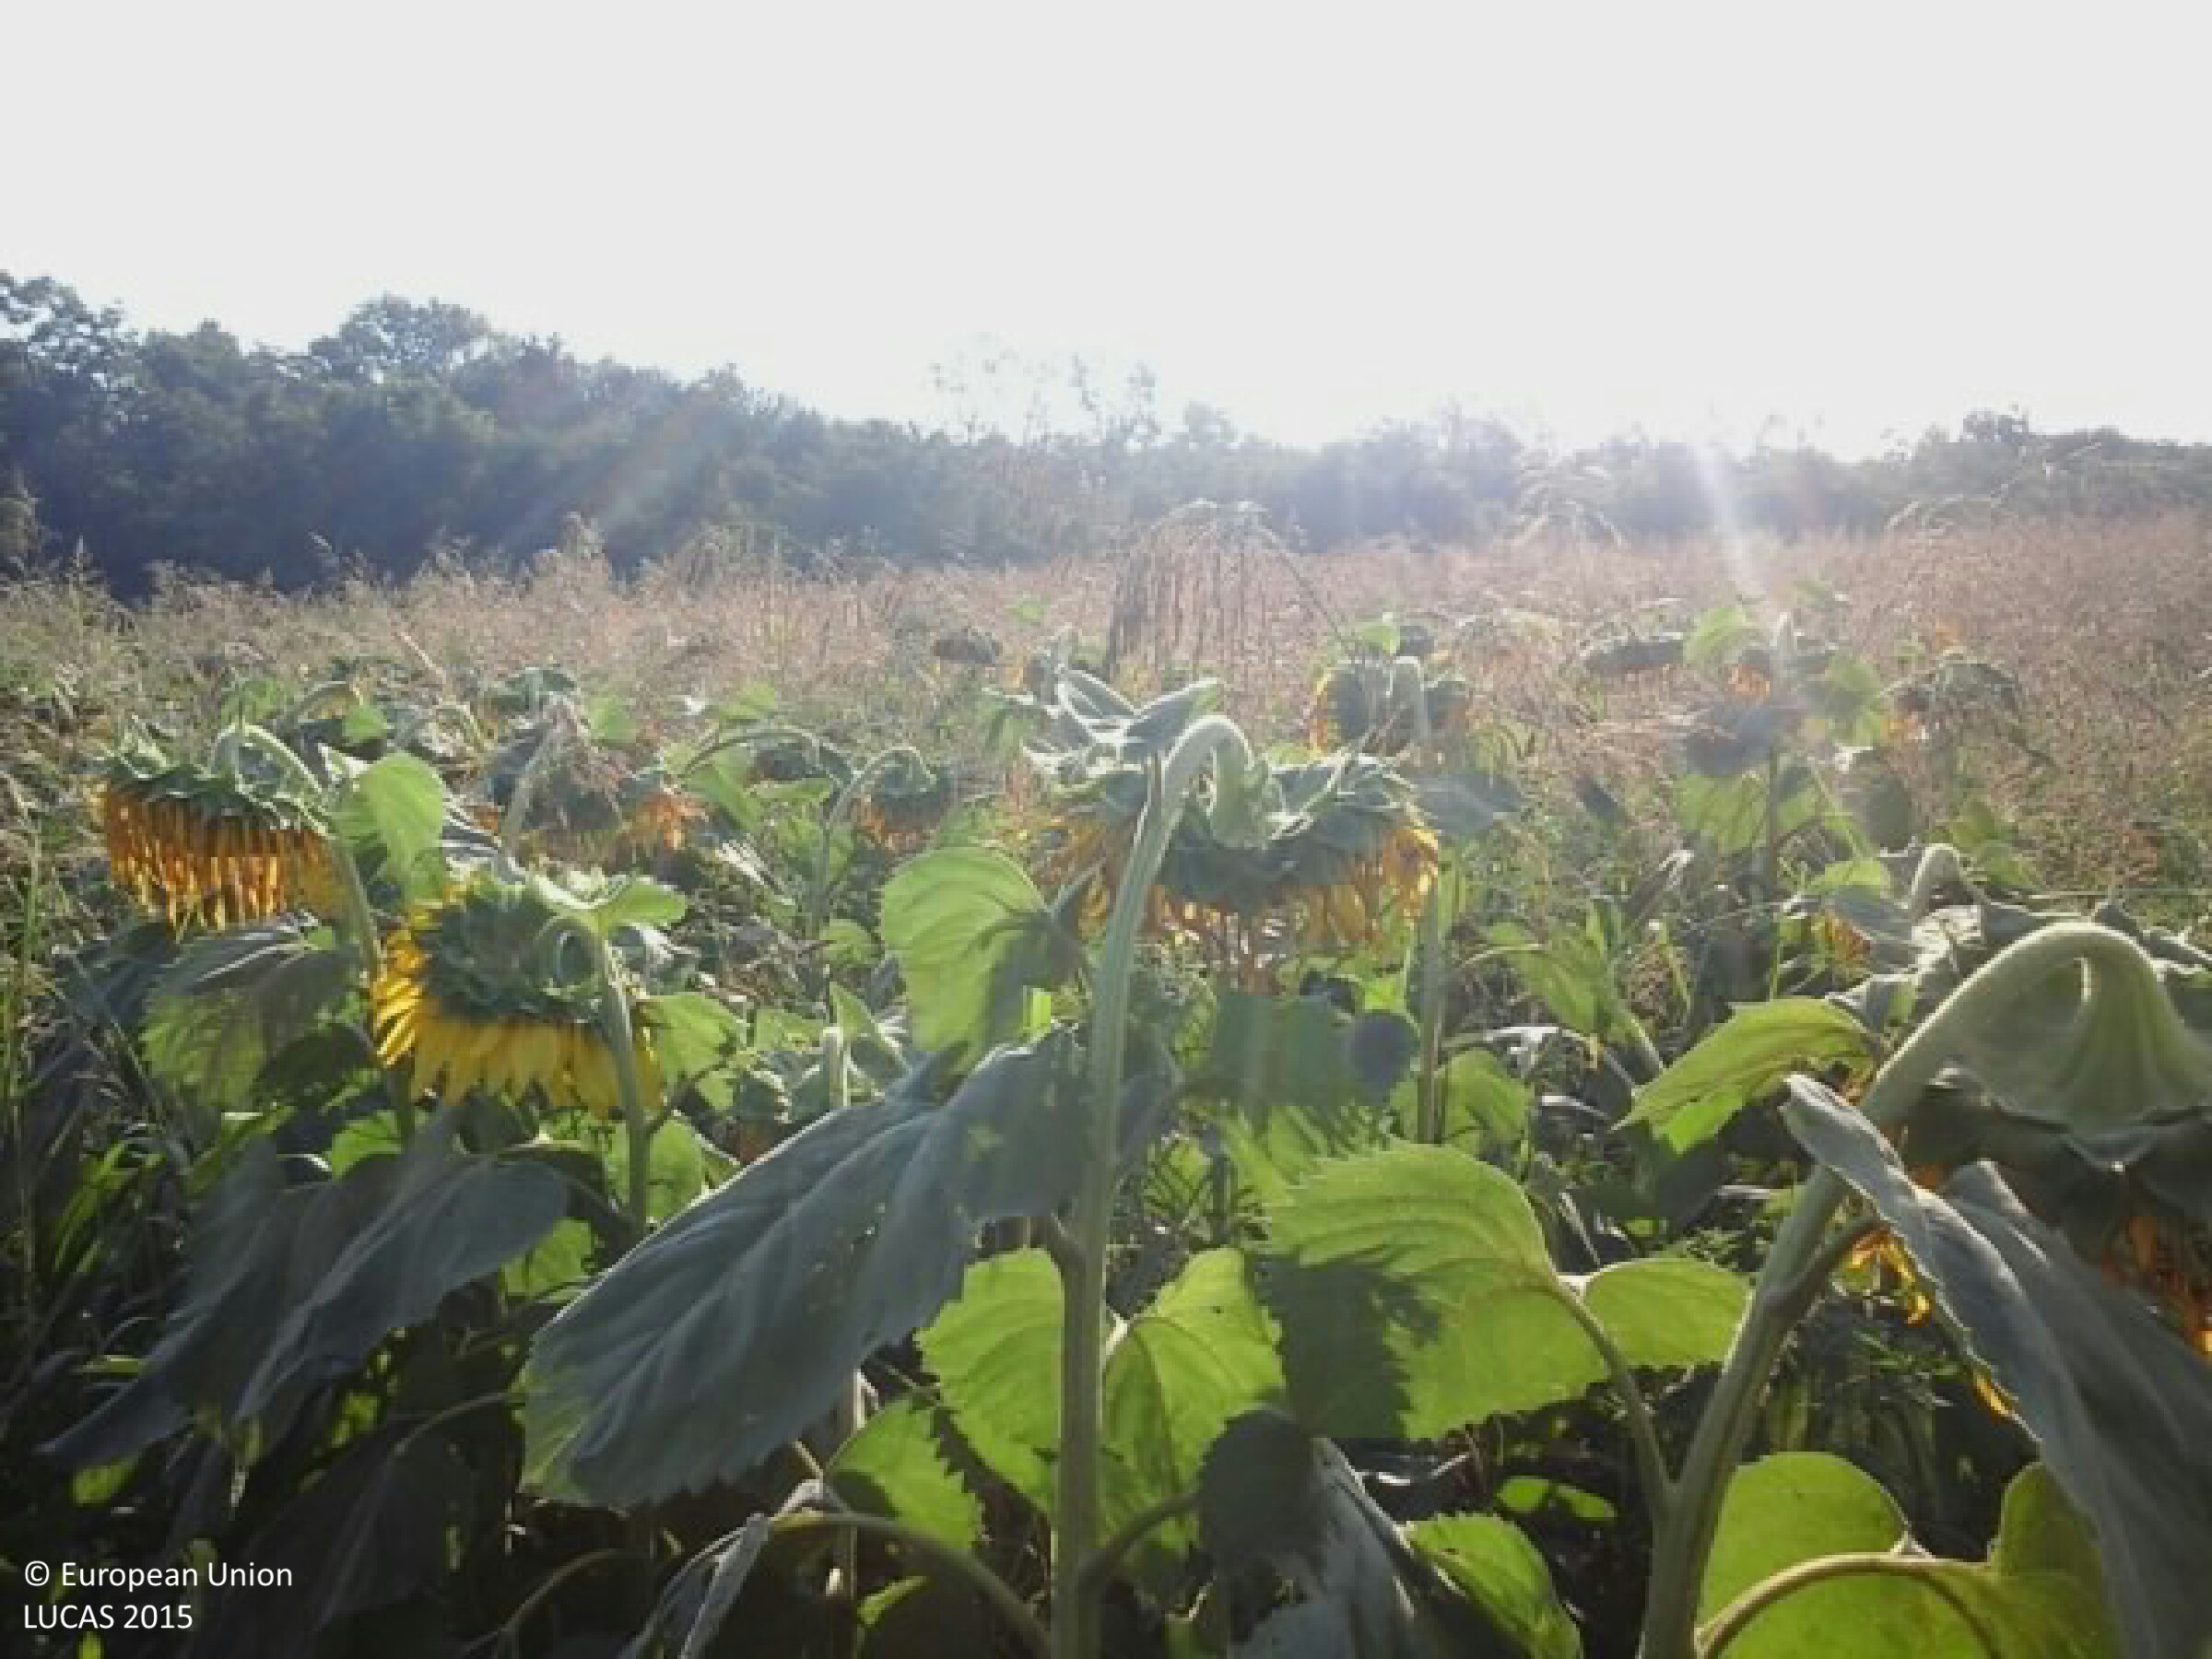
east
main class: Cropland
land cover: Sunflower
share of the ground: > 75 %
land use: Agriculture (excluding fallow land and kitchen gardens)
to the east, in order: Sunflower; Electric lines; Sunflower; Maize; Grass margins; Tracks; Grass margins; Broadleaved woodland
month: August
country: HU
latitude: 47.3051
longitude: 19.0774
